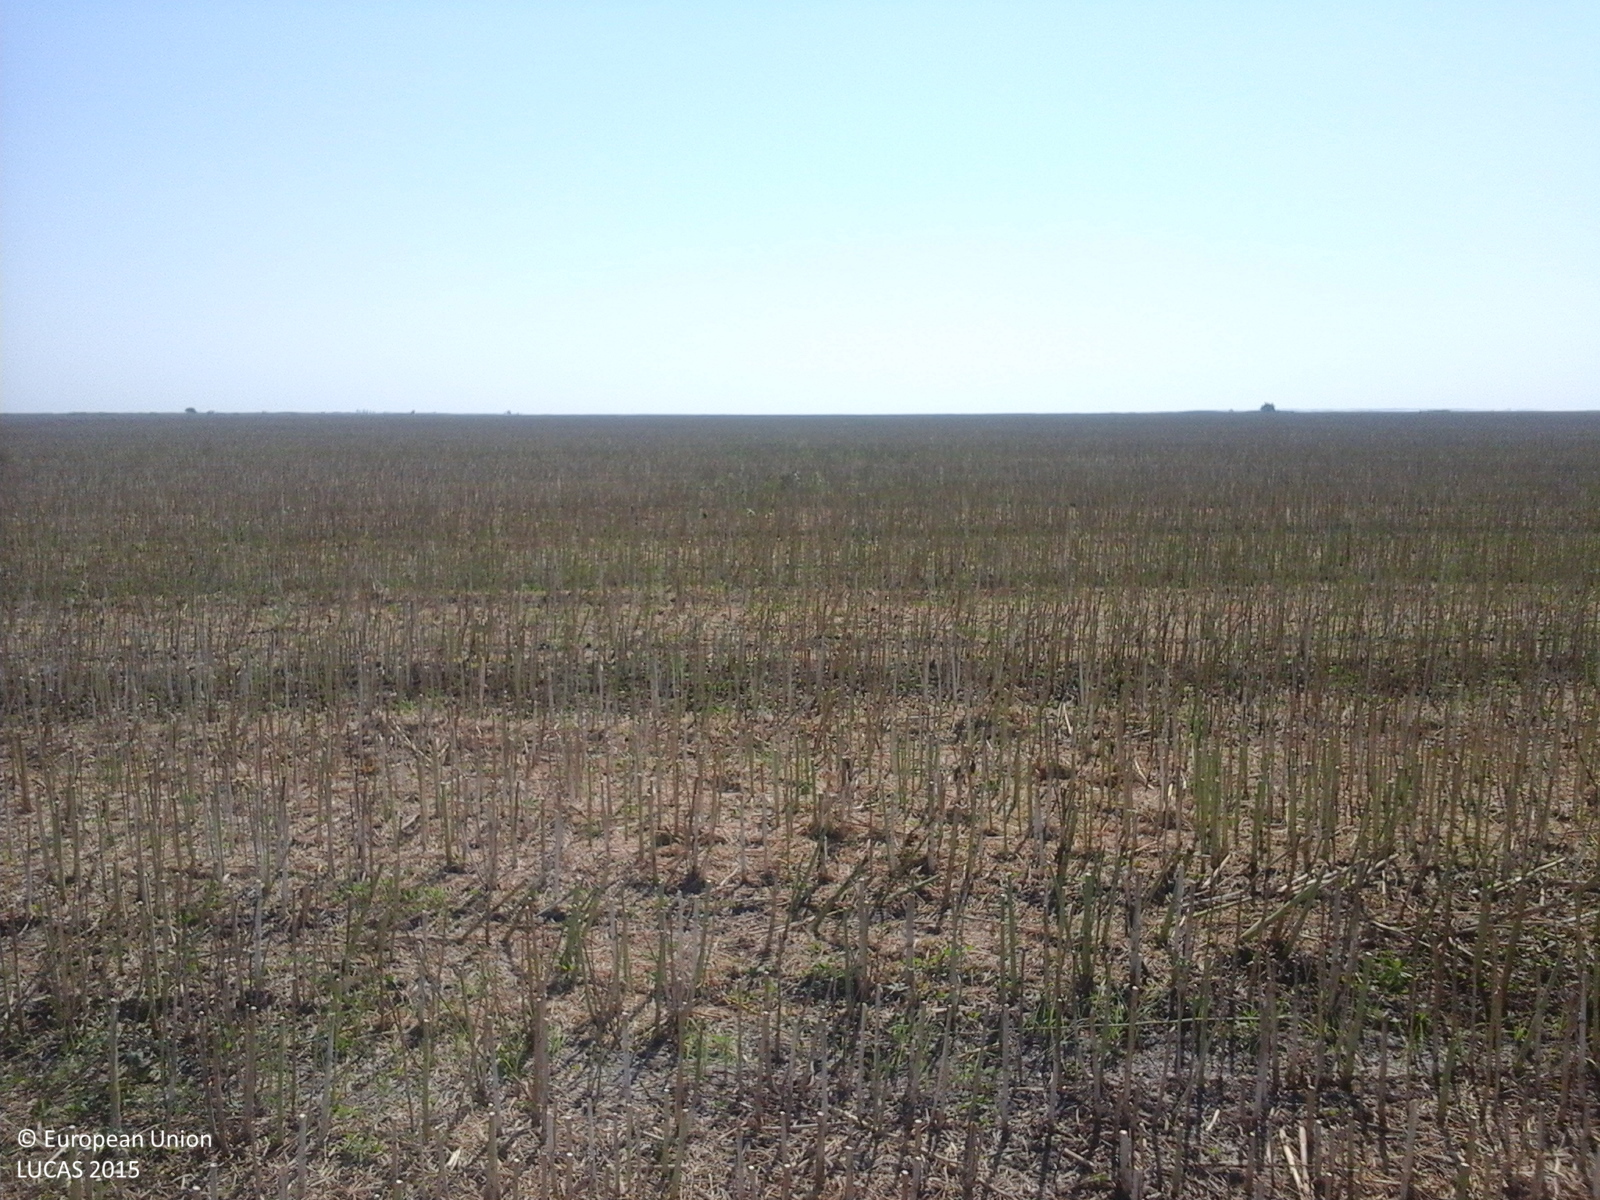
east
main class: Cropland
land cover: Rape and turnip rape
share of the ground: < 10 %
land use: Agriculture (excluding fallow land and kitchen gardens)
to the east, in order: Rape and turnip rape
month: July
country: RO
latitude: 44.0778
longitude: 24.7444
